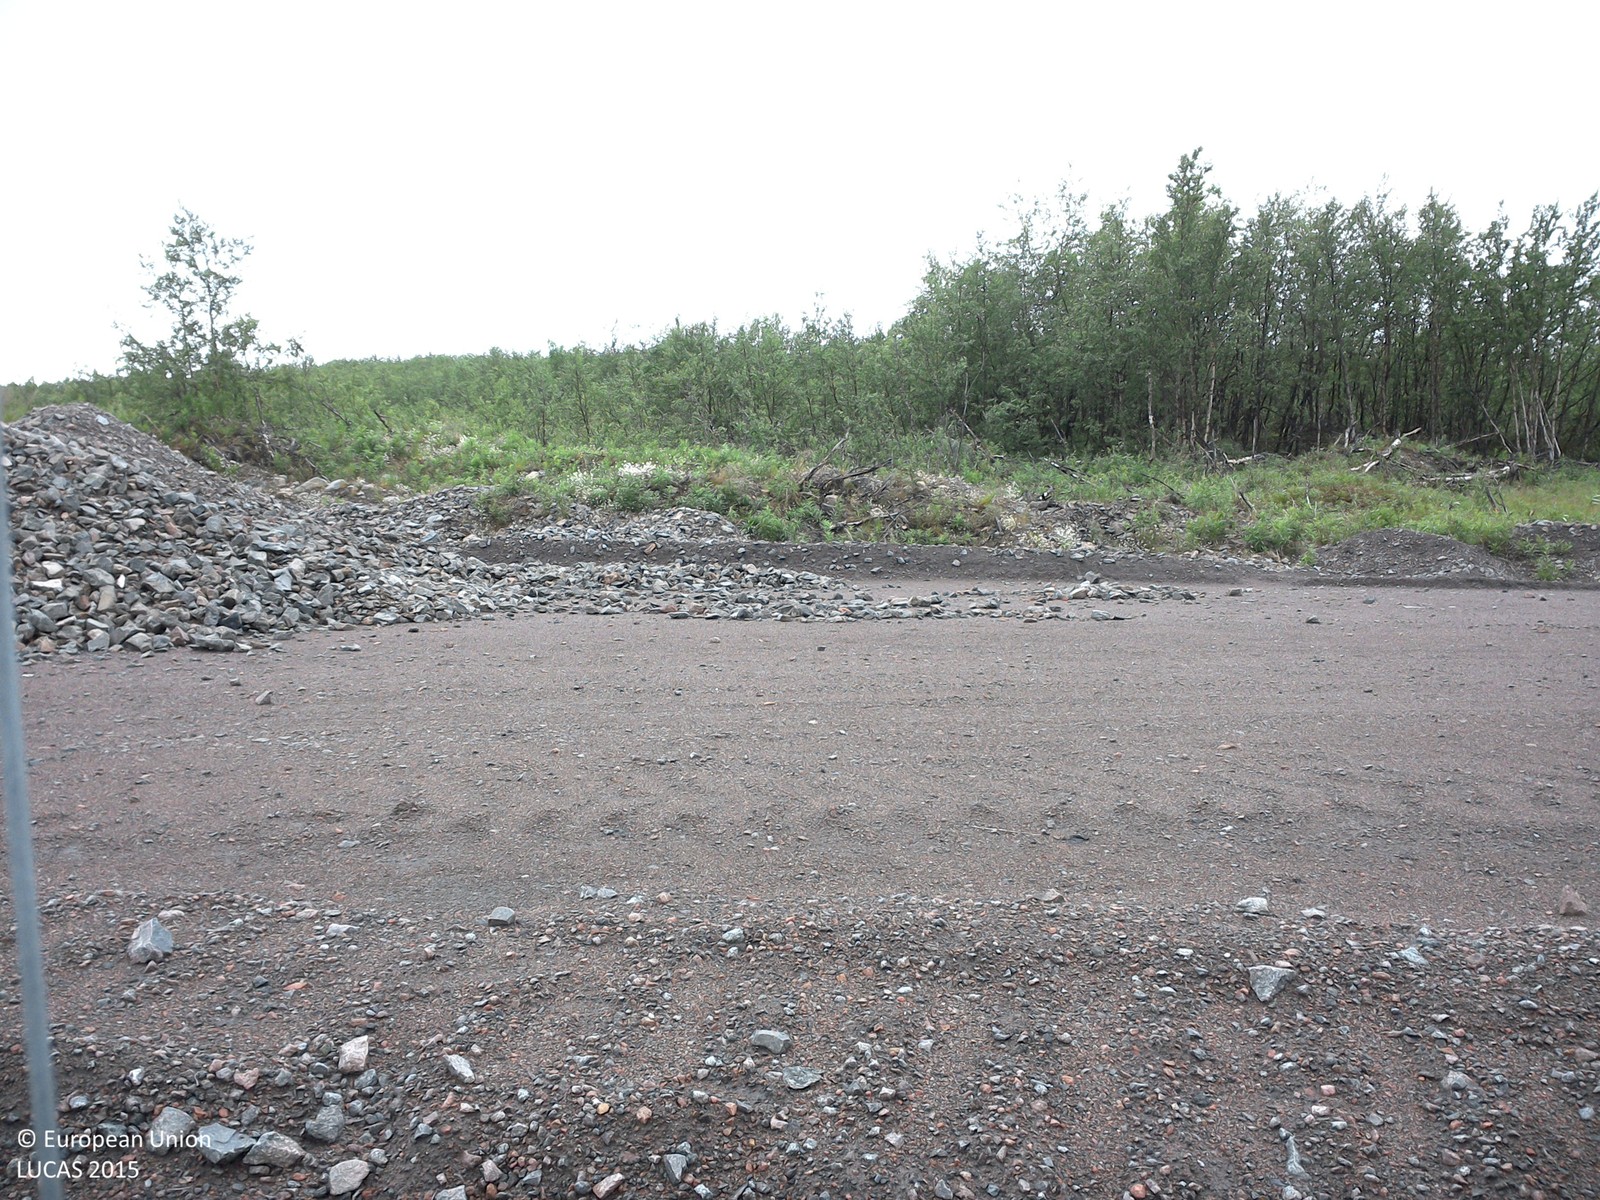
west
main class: Woodland
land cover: Broadleaved woodland
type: boreal forest
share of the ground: 25 - 50 %
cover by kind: shrubs 60 %, broadleaved forest trees 40 %
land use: Mining and quarrying
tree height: < 5 m
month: August
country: SE
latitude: 67.8138
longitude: 20.2147
